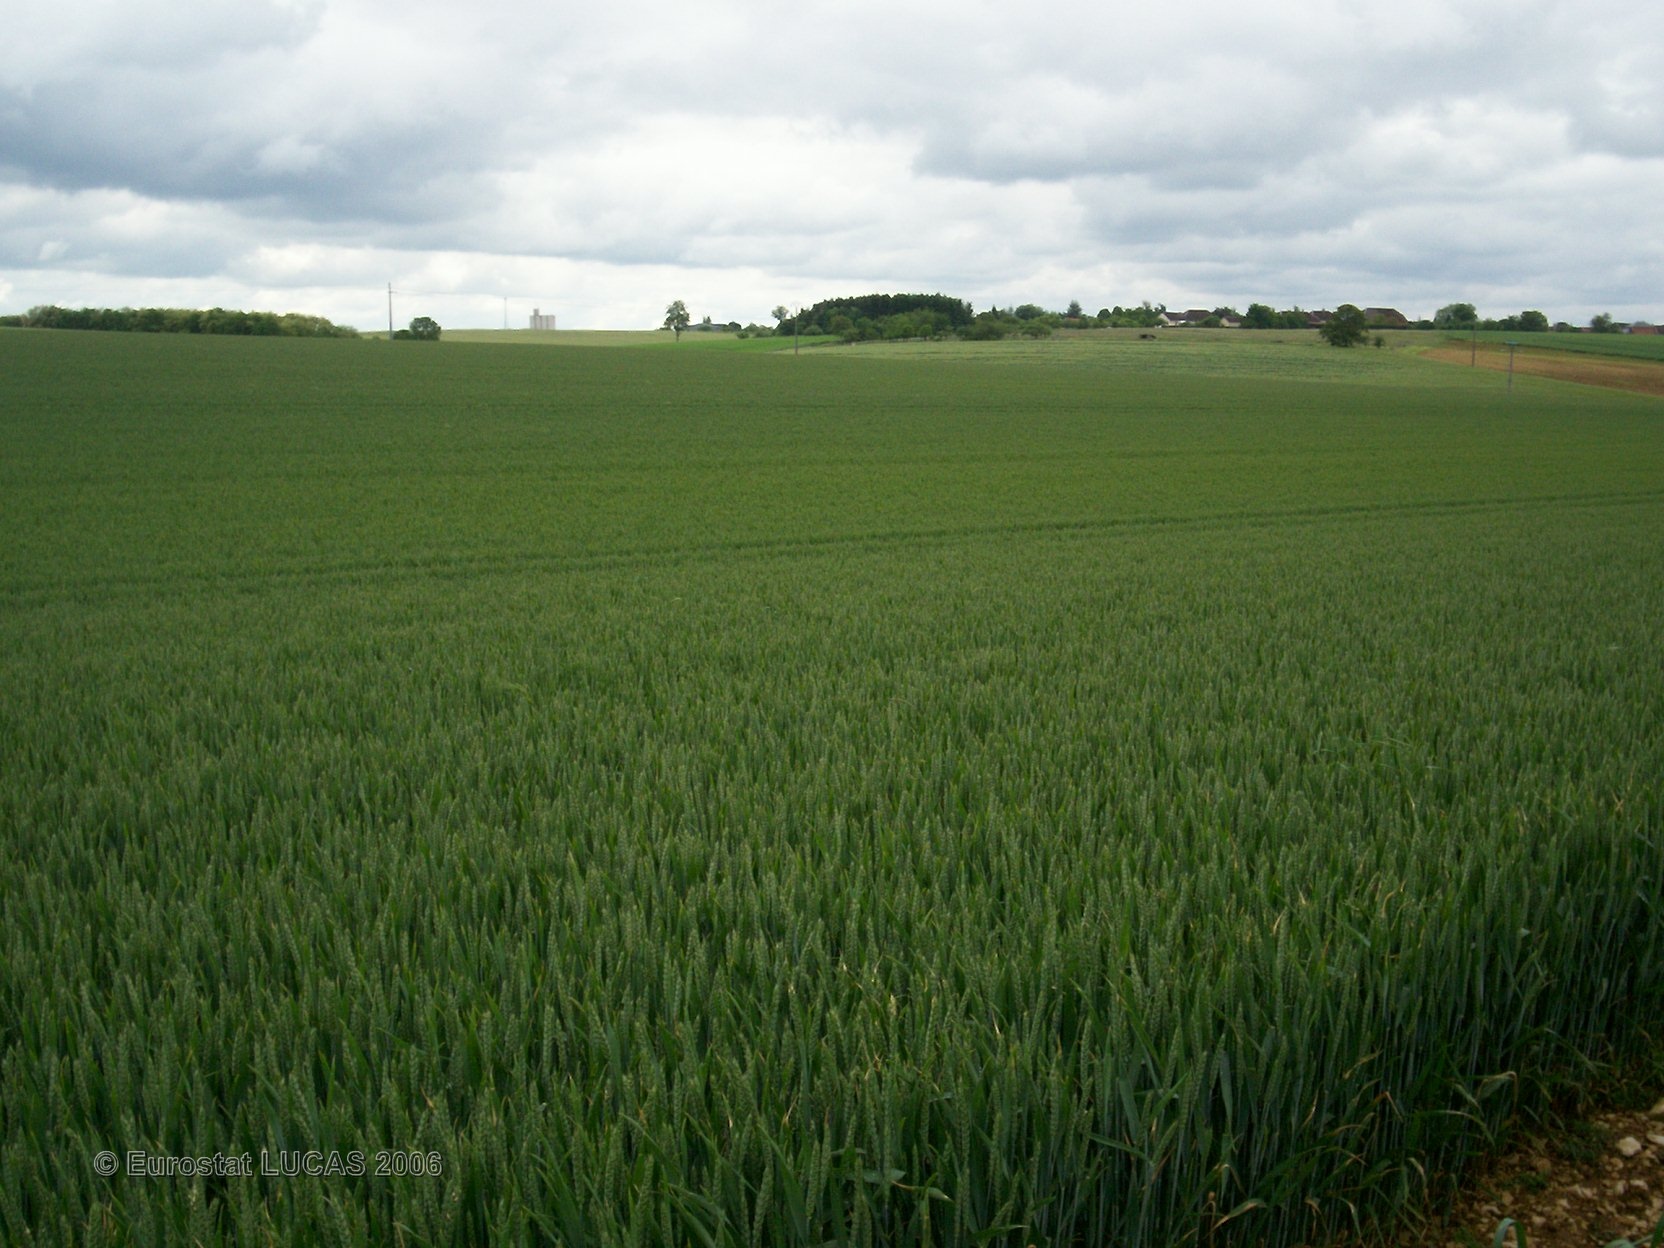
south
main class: Cropland
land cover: Common wheat
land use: Agriculture (excluding fallow land and kitchen gardens)
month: May
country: FR
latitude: 48.2507
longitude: 4.5432
